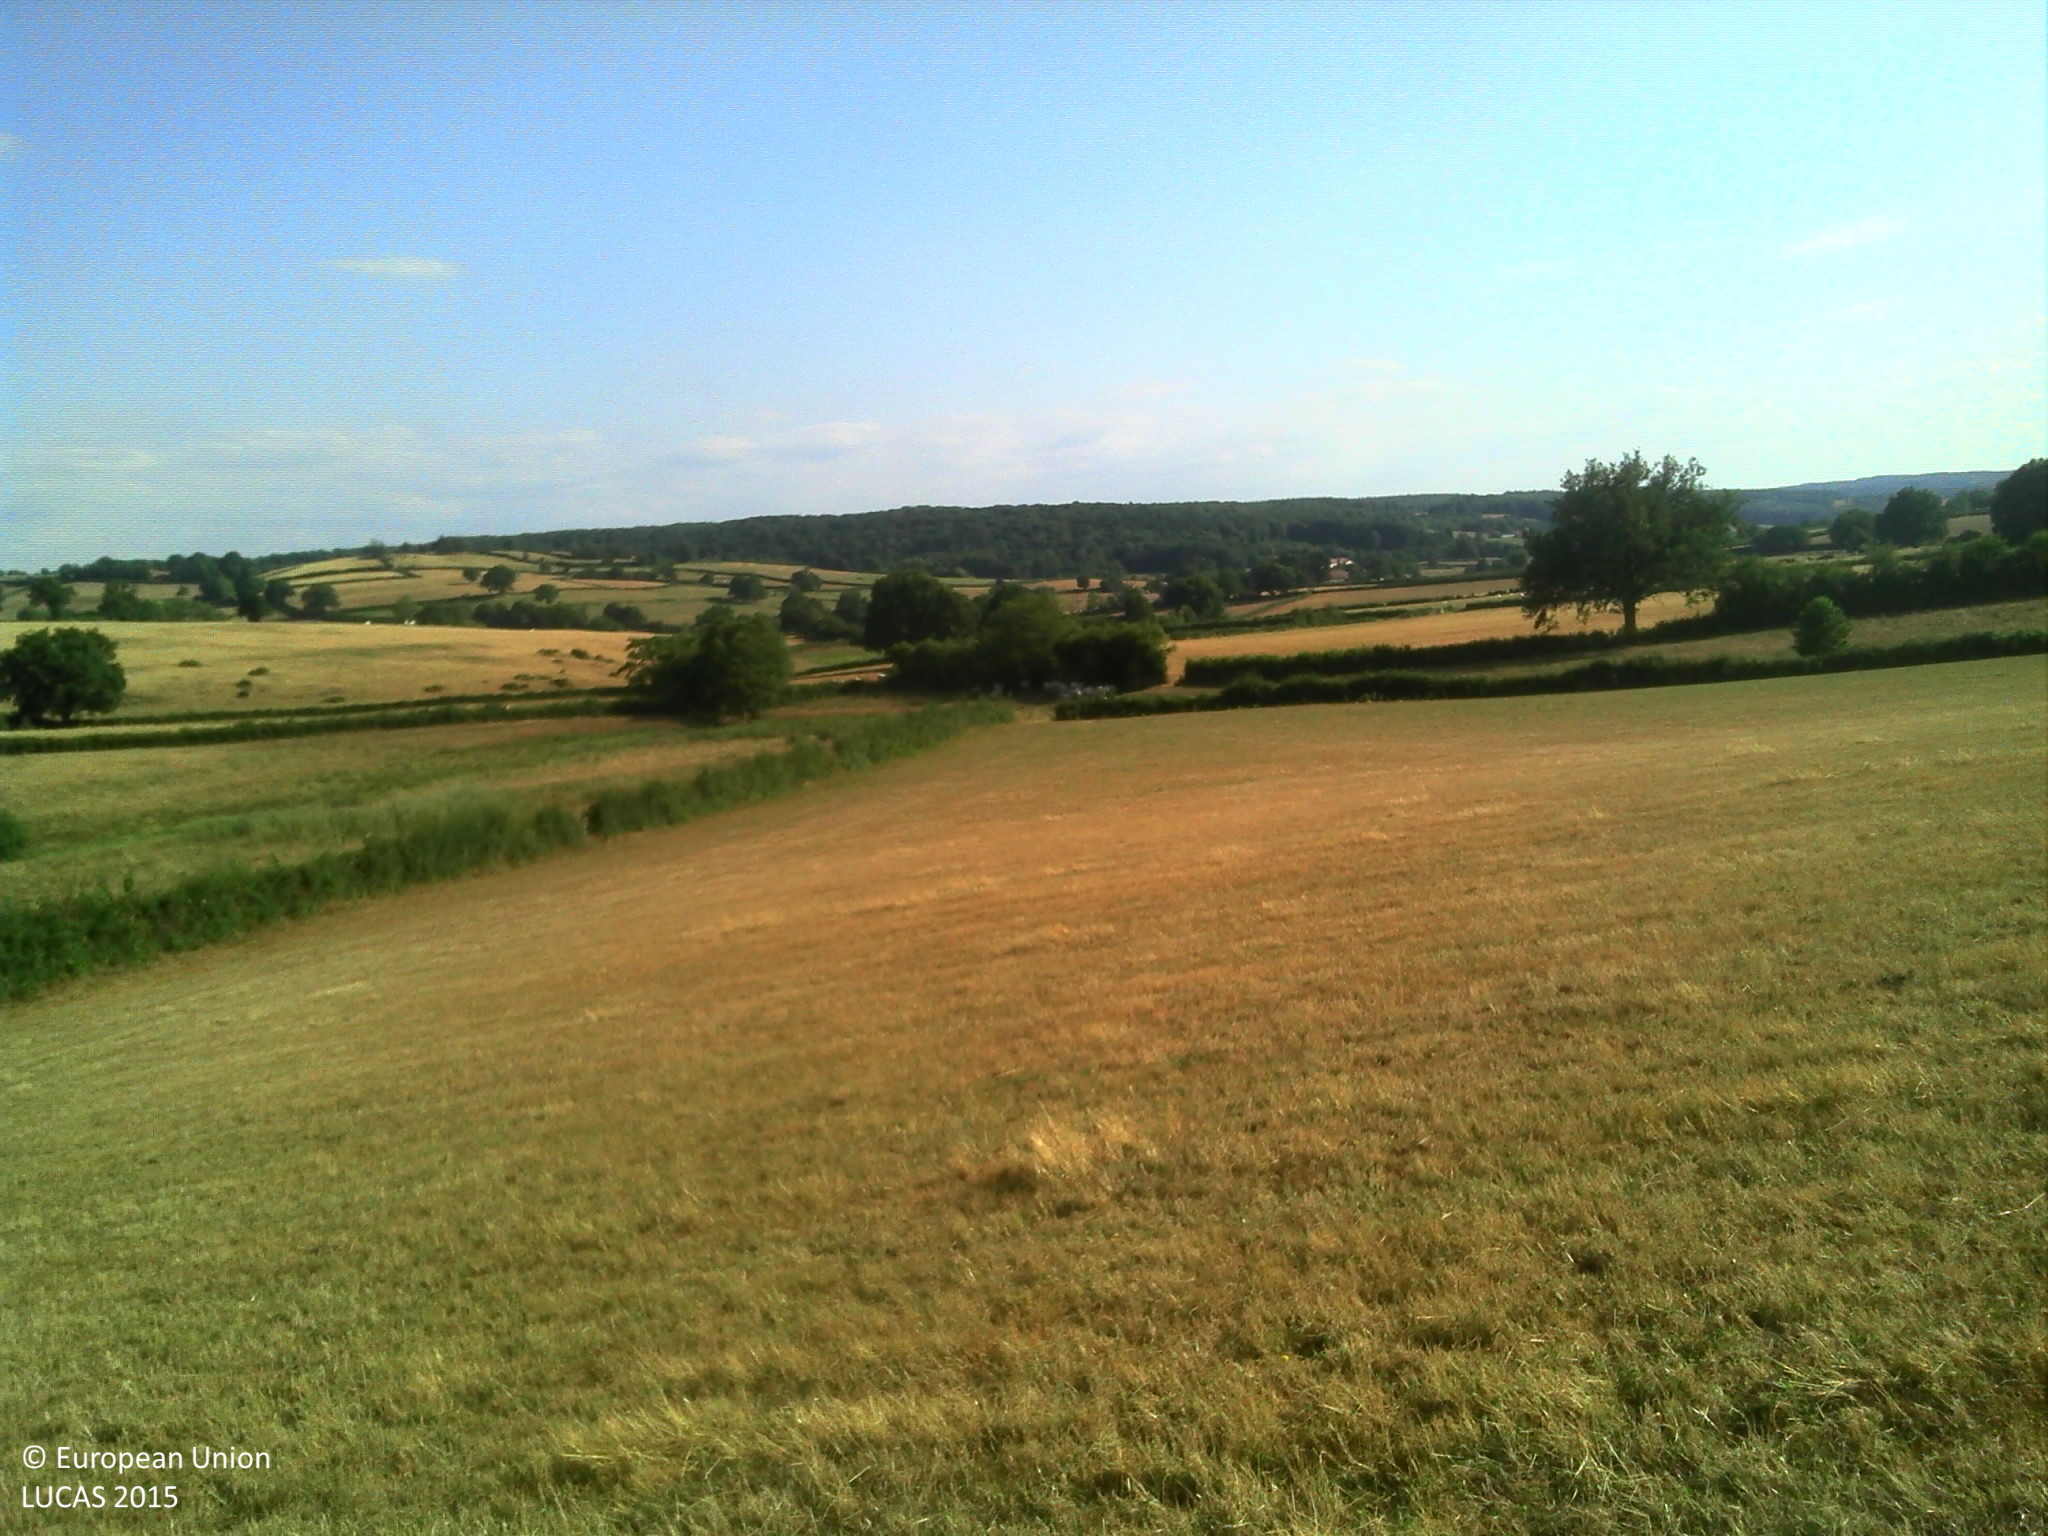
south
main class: Grassland
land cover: Grassland without tree/shrub cover
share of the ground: > 75 %
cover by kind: herbaceous plants 100 %
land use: Agriculture (excluding fallow land and kitchen gardens)
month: July
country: FR
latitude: 46.6183
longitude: 4.3725
